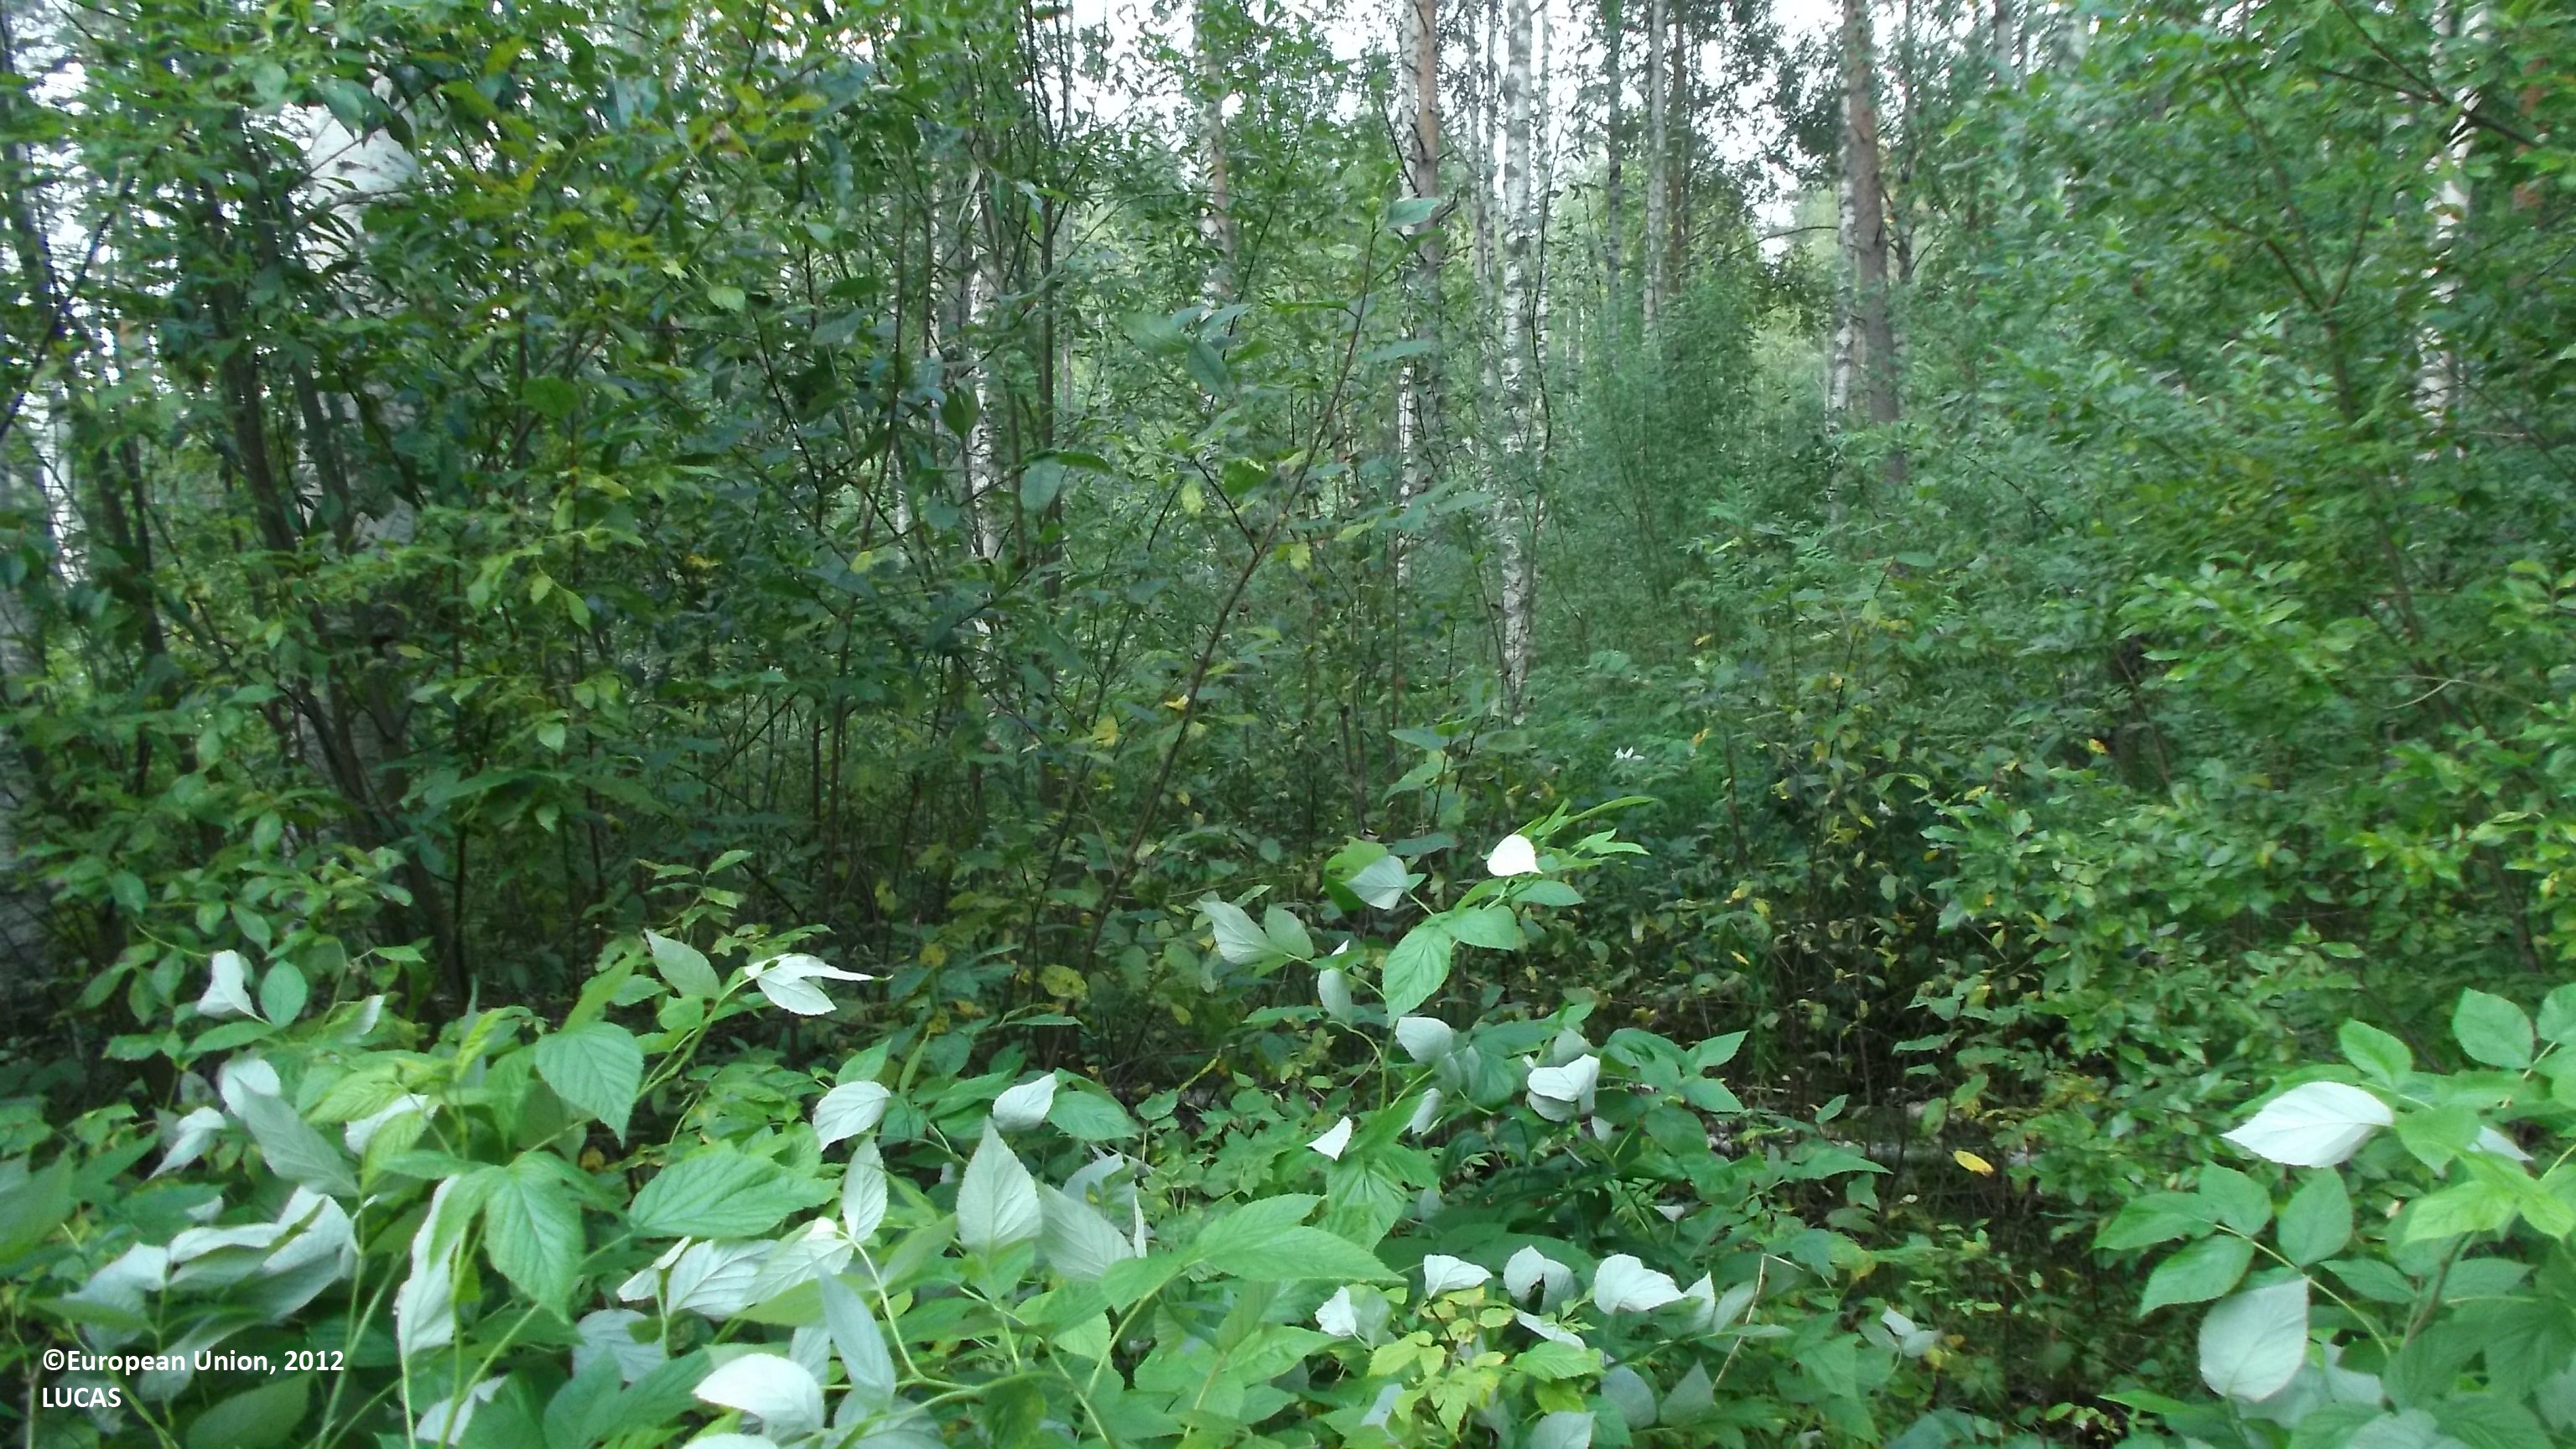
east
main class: Shrubland
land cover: Shrubland with sparse tree cover
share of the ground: 25 - 50 %
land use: Forestry
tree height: > 5 m
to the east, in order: Shrubland with sparse tree cover; Other mixed woodland; Ditches and canals; Grassland with sparse tree/shrub cover; Shrubland with sparse tree cover; Ditches and canals; Shrubland with sparse tree cover; Ditches and canals; Shrubland with sparse tree cover; Rivers and streams; Other mixed woodland; Rivers and streams; Other mixed woodland; Ditches and canals; Tracks; Ditches and canals; Pine dominated coniferous woodland; Pine dominated mixed woodland; Broadleaved woodland; Inland running water; Broadleaved woodland; Pine dominated mixed woodland
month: August
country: FI
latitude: 63.0745
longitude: 24.3932
